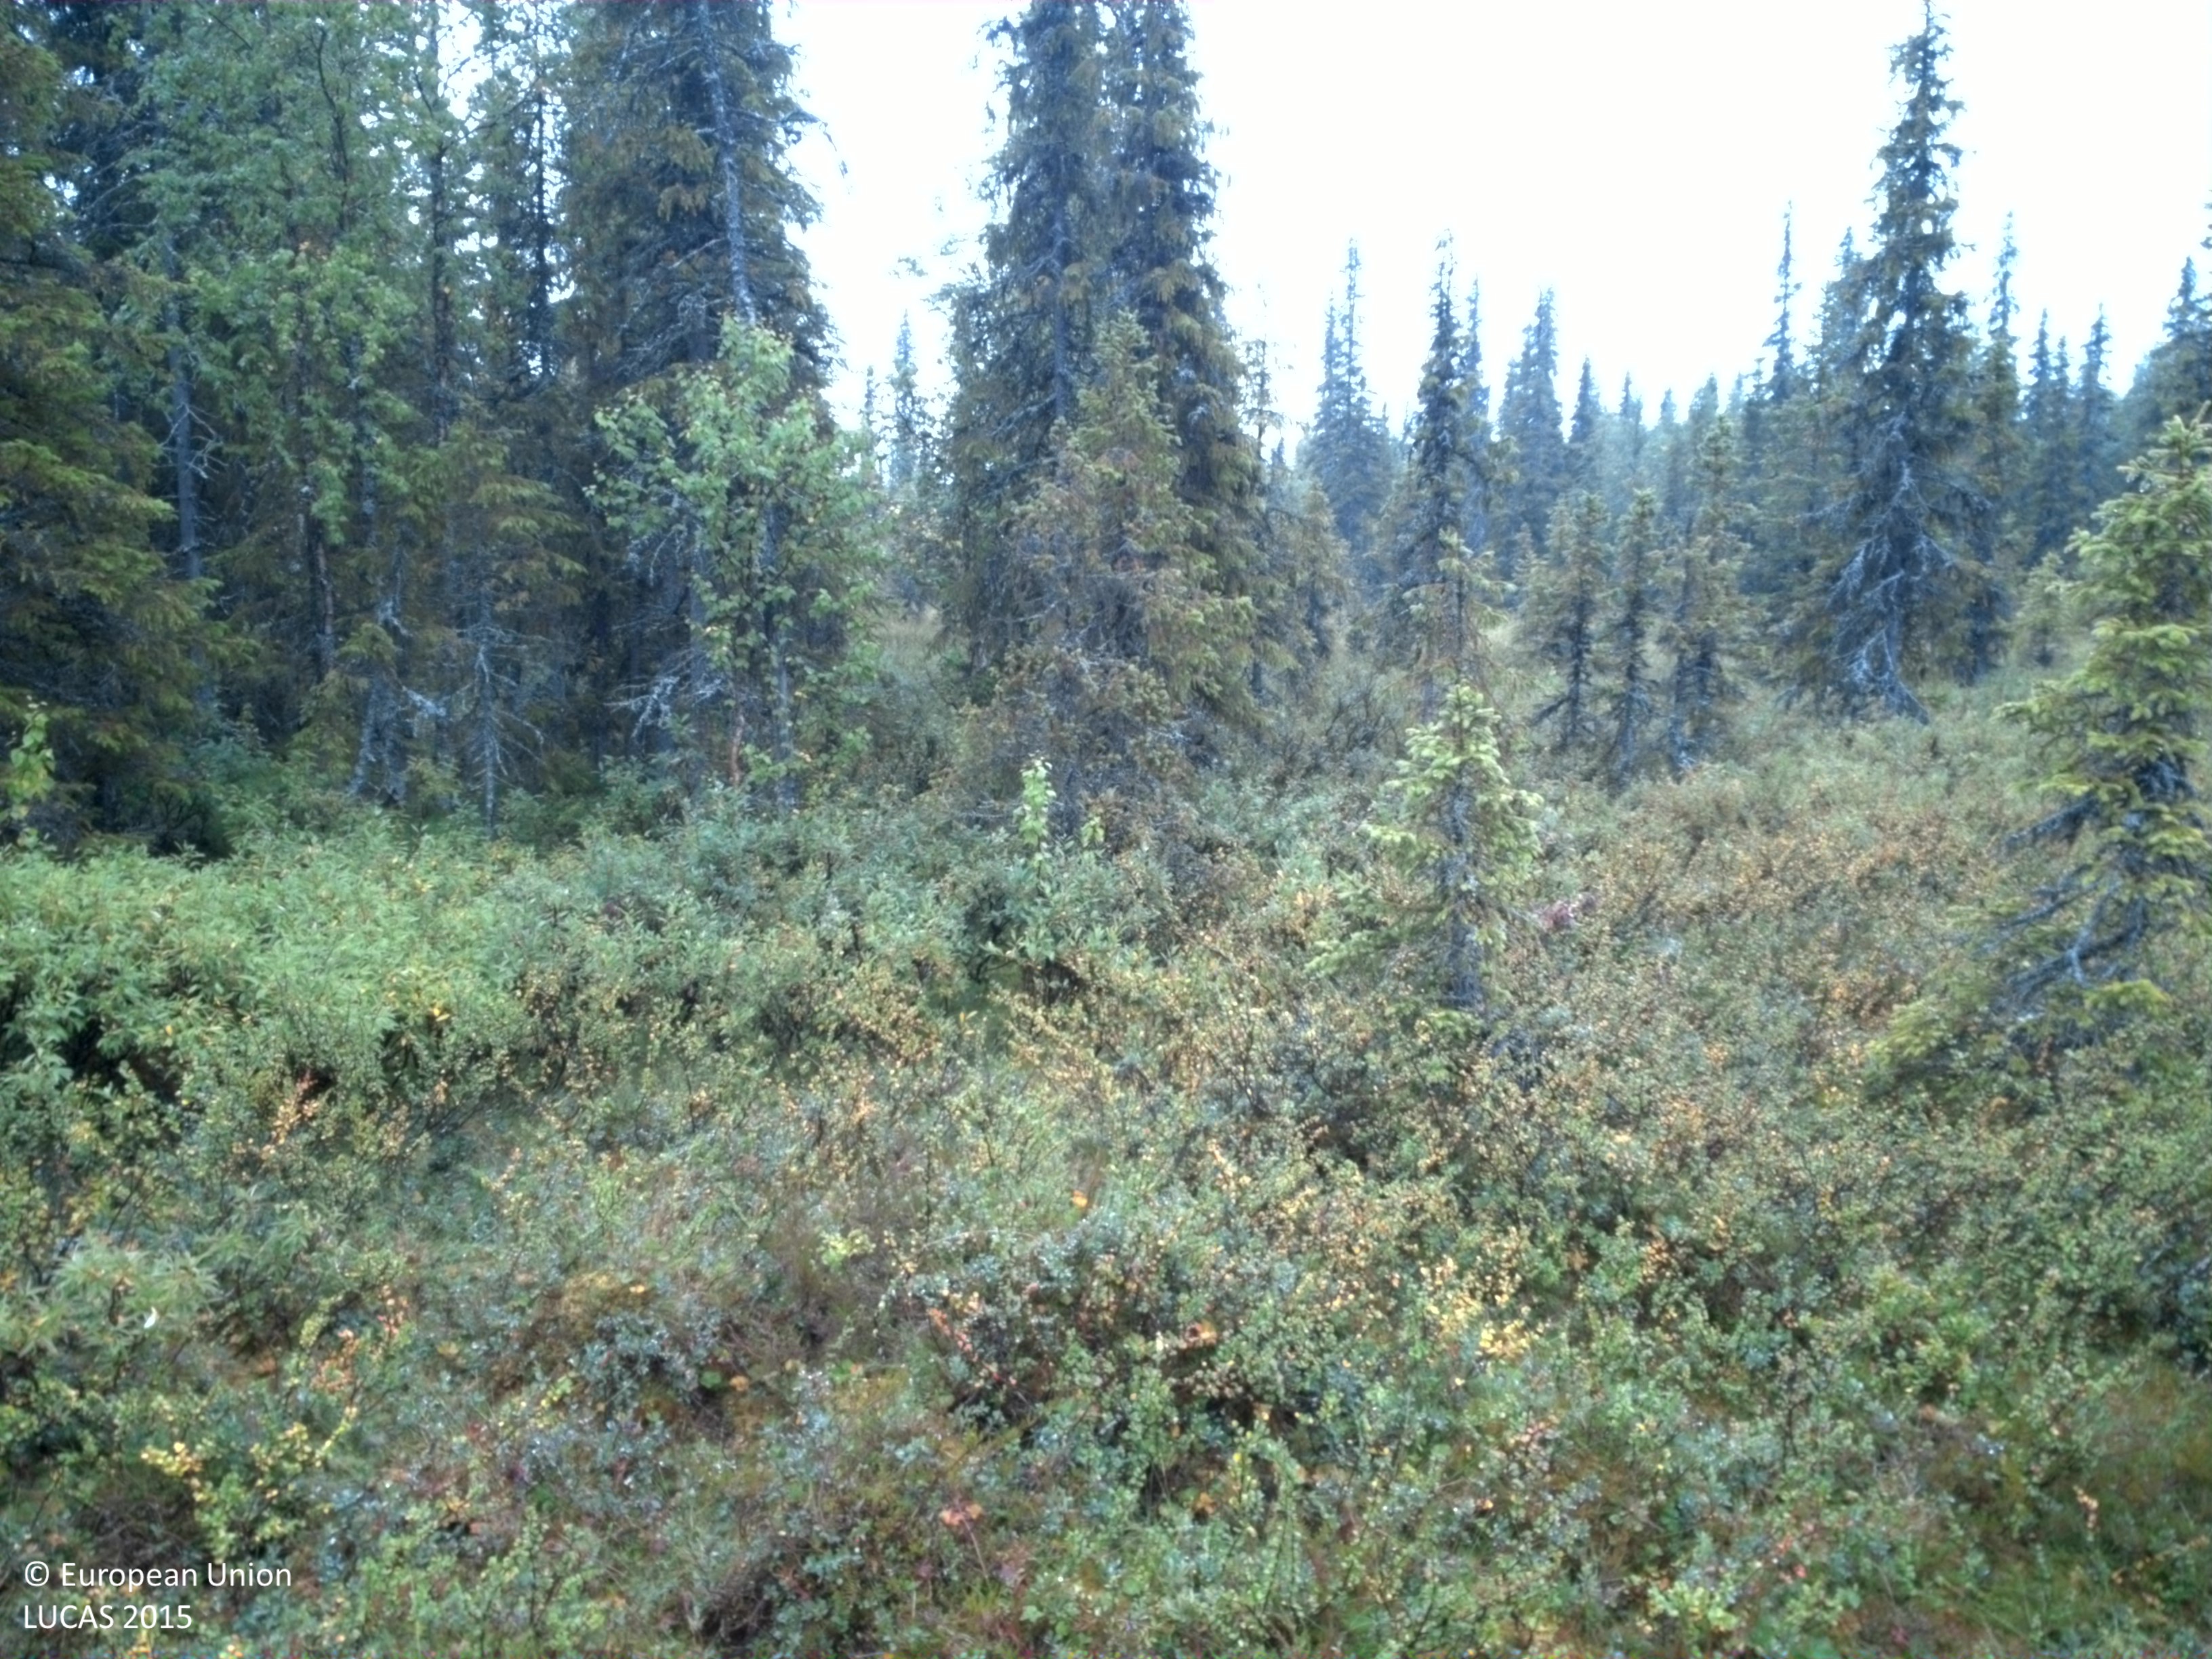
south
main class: Shrubland
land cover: Shrubland without tree cover
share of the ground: 50 - 75 %
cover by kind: shrubs 50 %, lichens and mosses 30 %, herbaceous plants 20 %
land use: Semi-natural and natural areas not in use
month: August
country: SE
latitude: 64.8442
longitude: 16.5228
